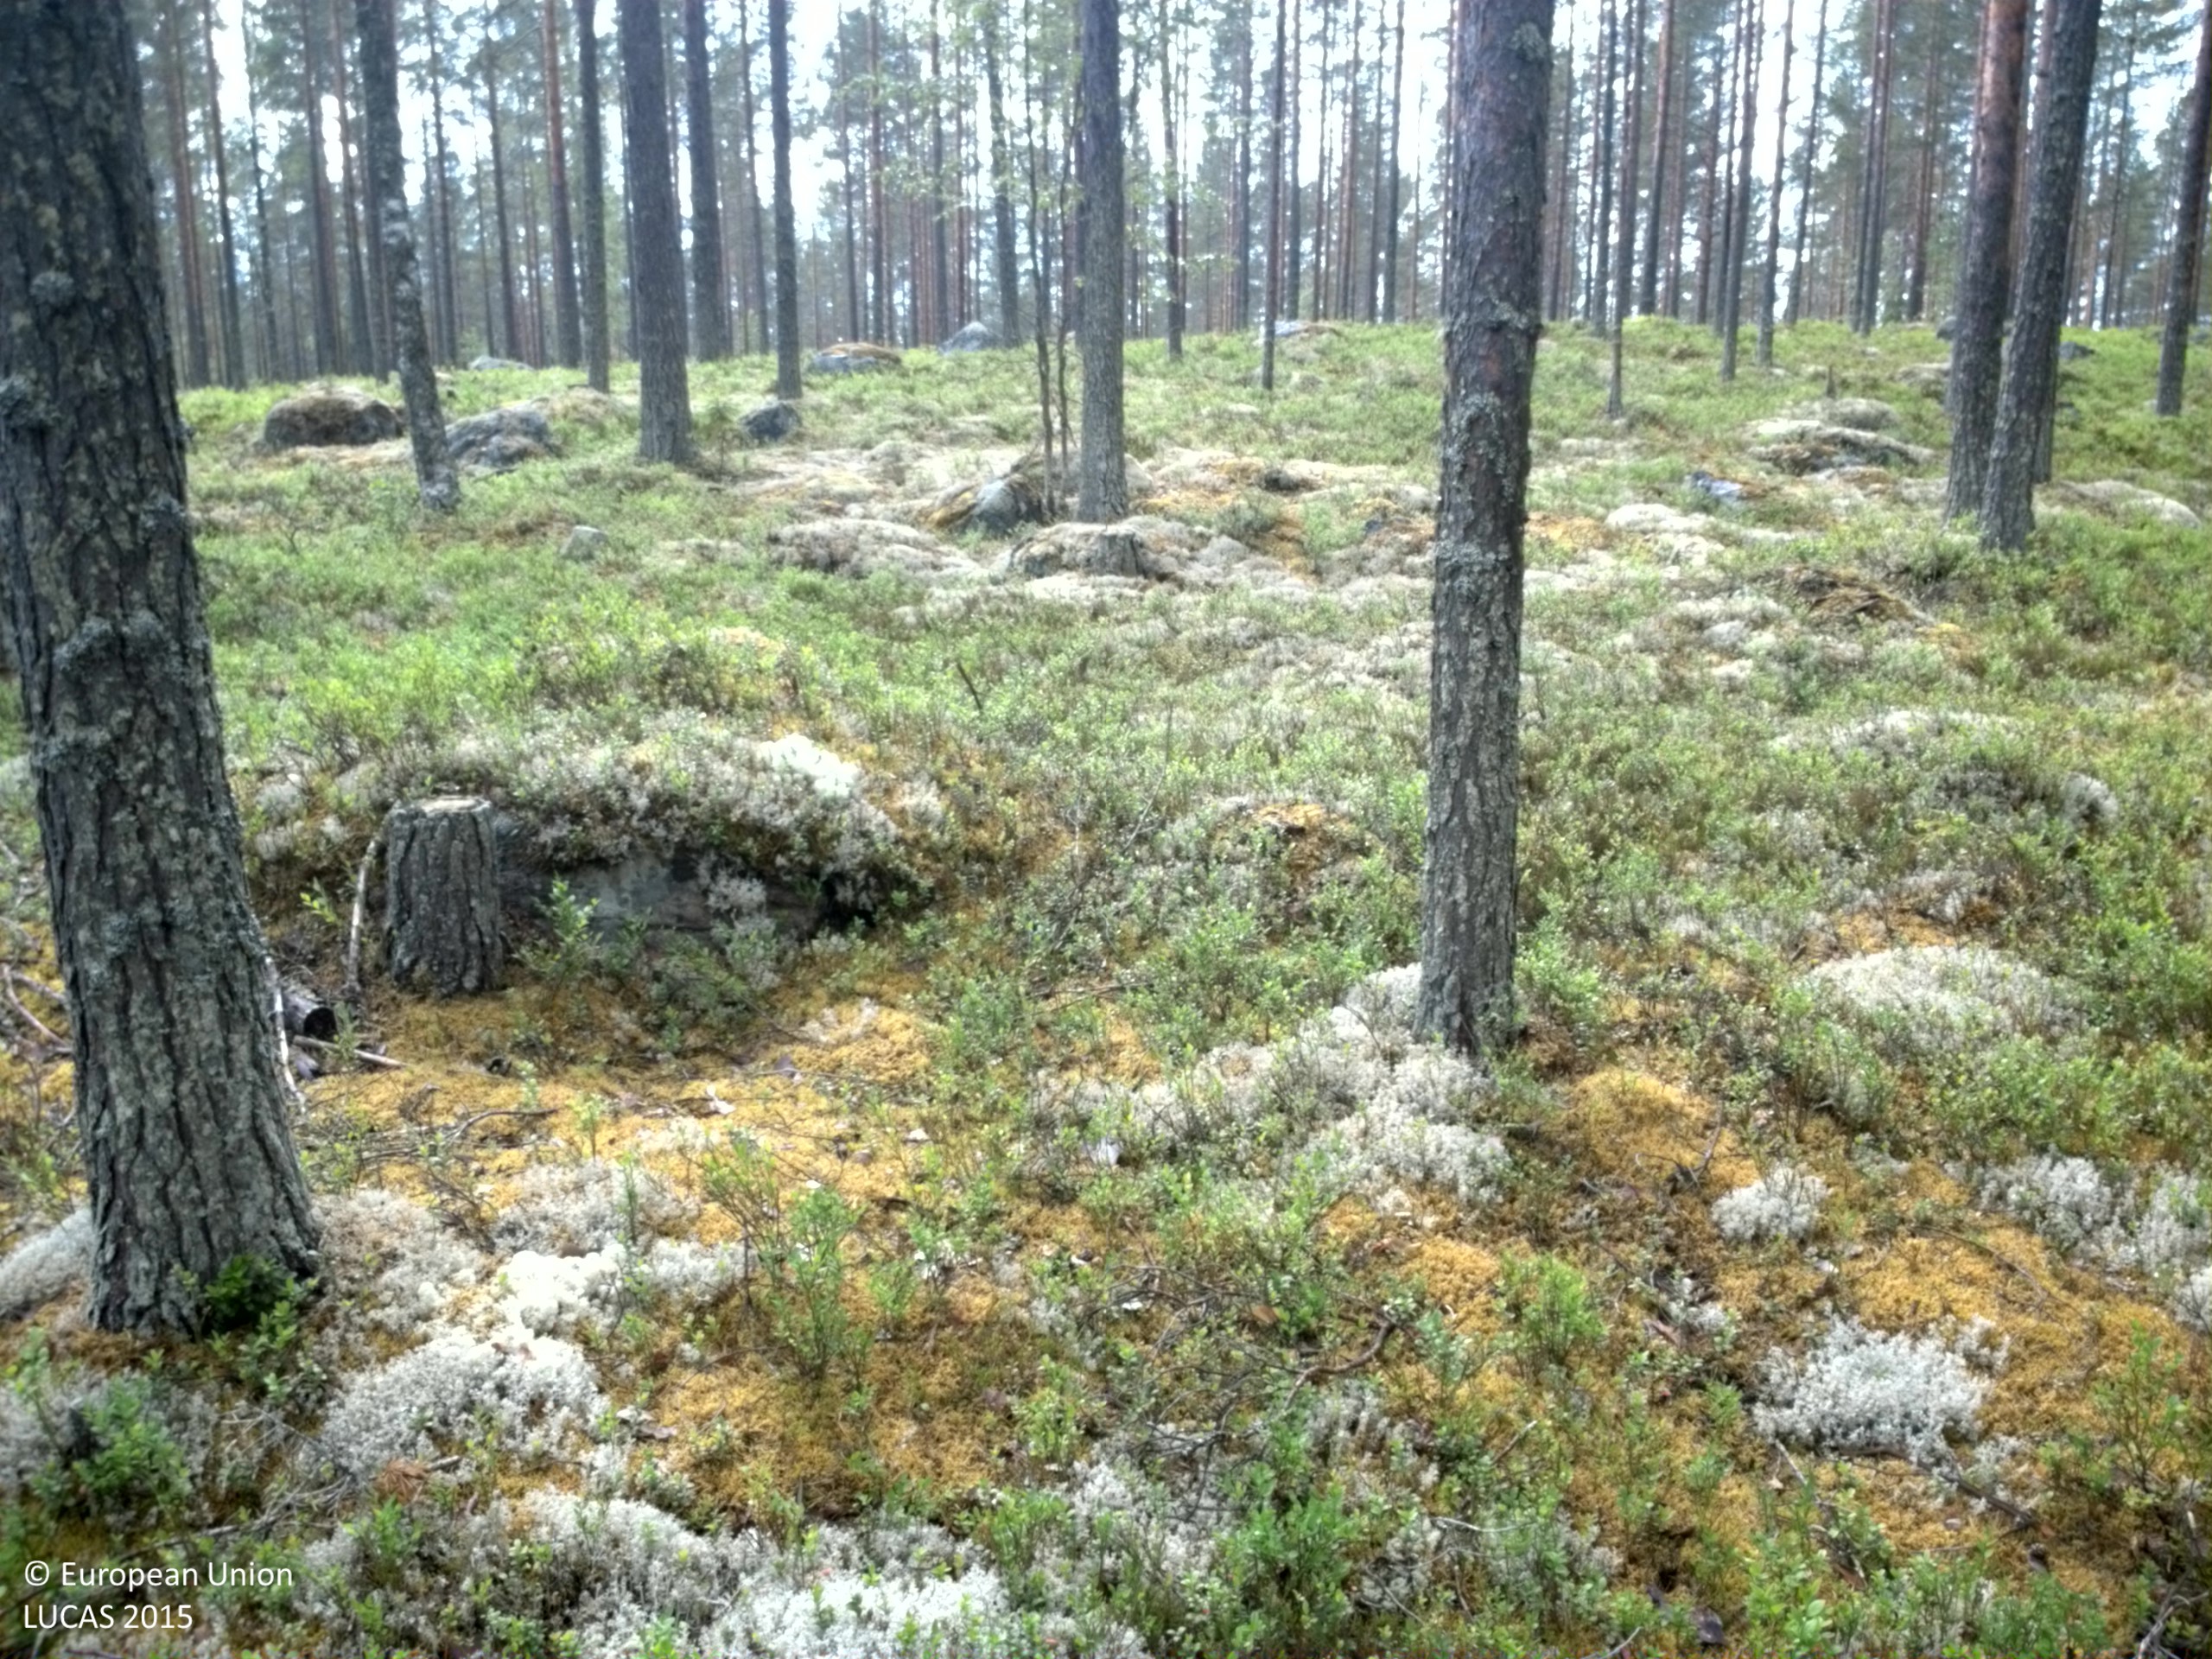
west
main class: Woodland
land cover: Pine dominated coniferous woodland
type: boreal forest
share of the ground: 50 - 75 %
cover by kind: coniferous forest trees 75 %, lichens and mosses 15 %, shrubs 10 %
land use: Forestry
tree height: > 5 m
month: July
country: SE
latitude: 63.2284
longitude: 17.7567
